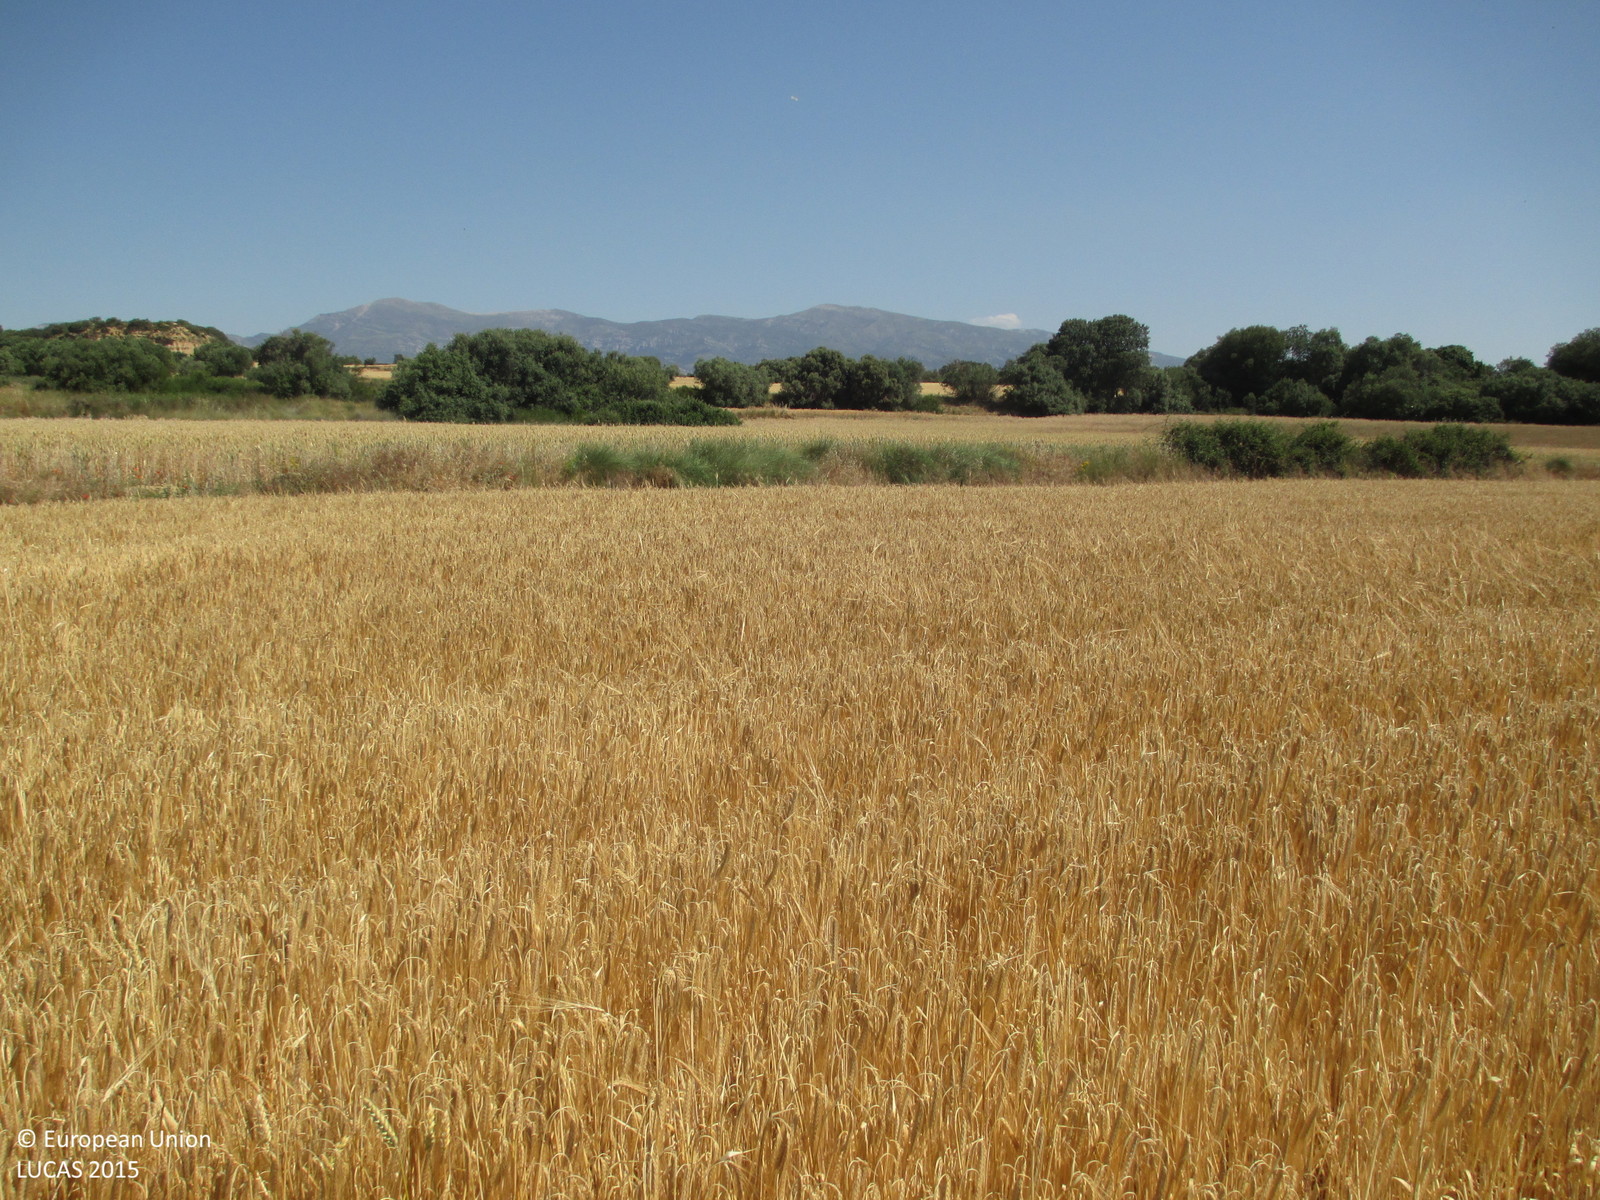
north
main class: Cropland
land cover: Barley
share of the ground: > 75 %
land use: Agriculture (excluding fallow land and kitchen gardens)
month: June
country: ES
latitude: 42.1561
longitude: -0.1994
